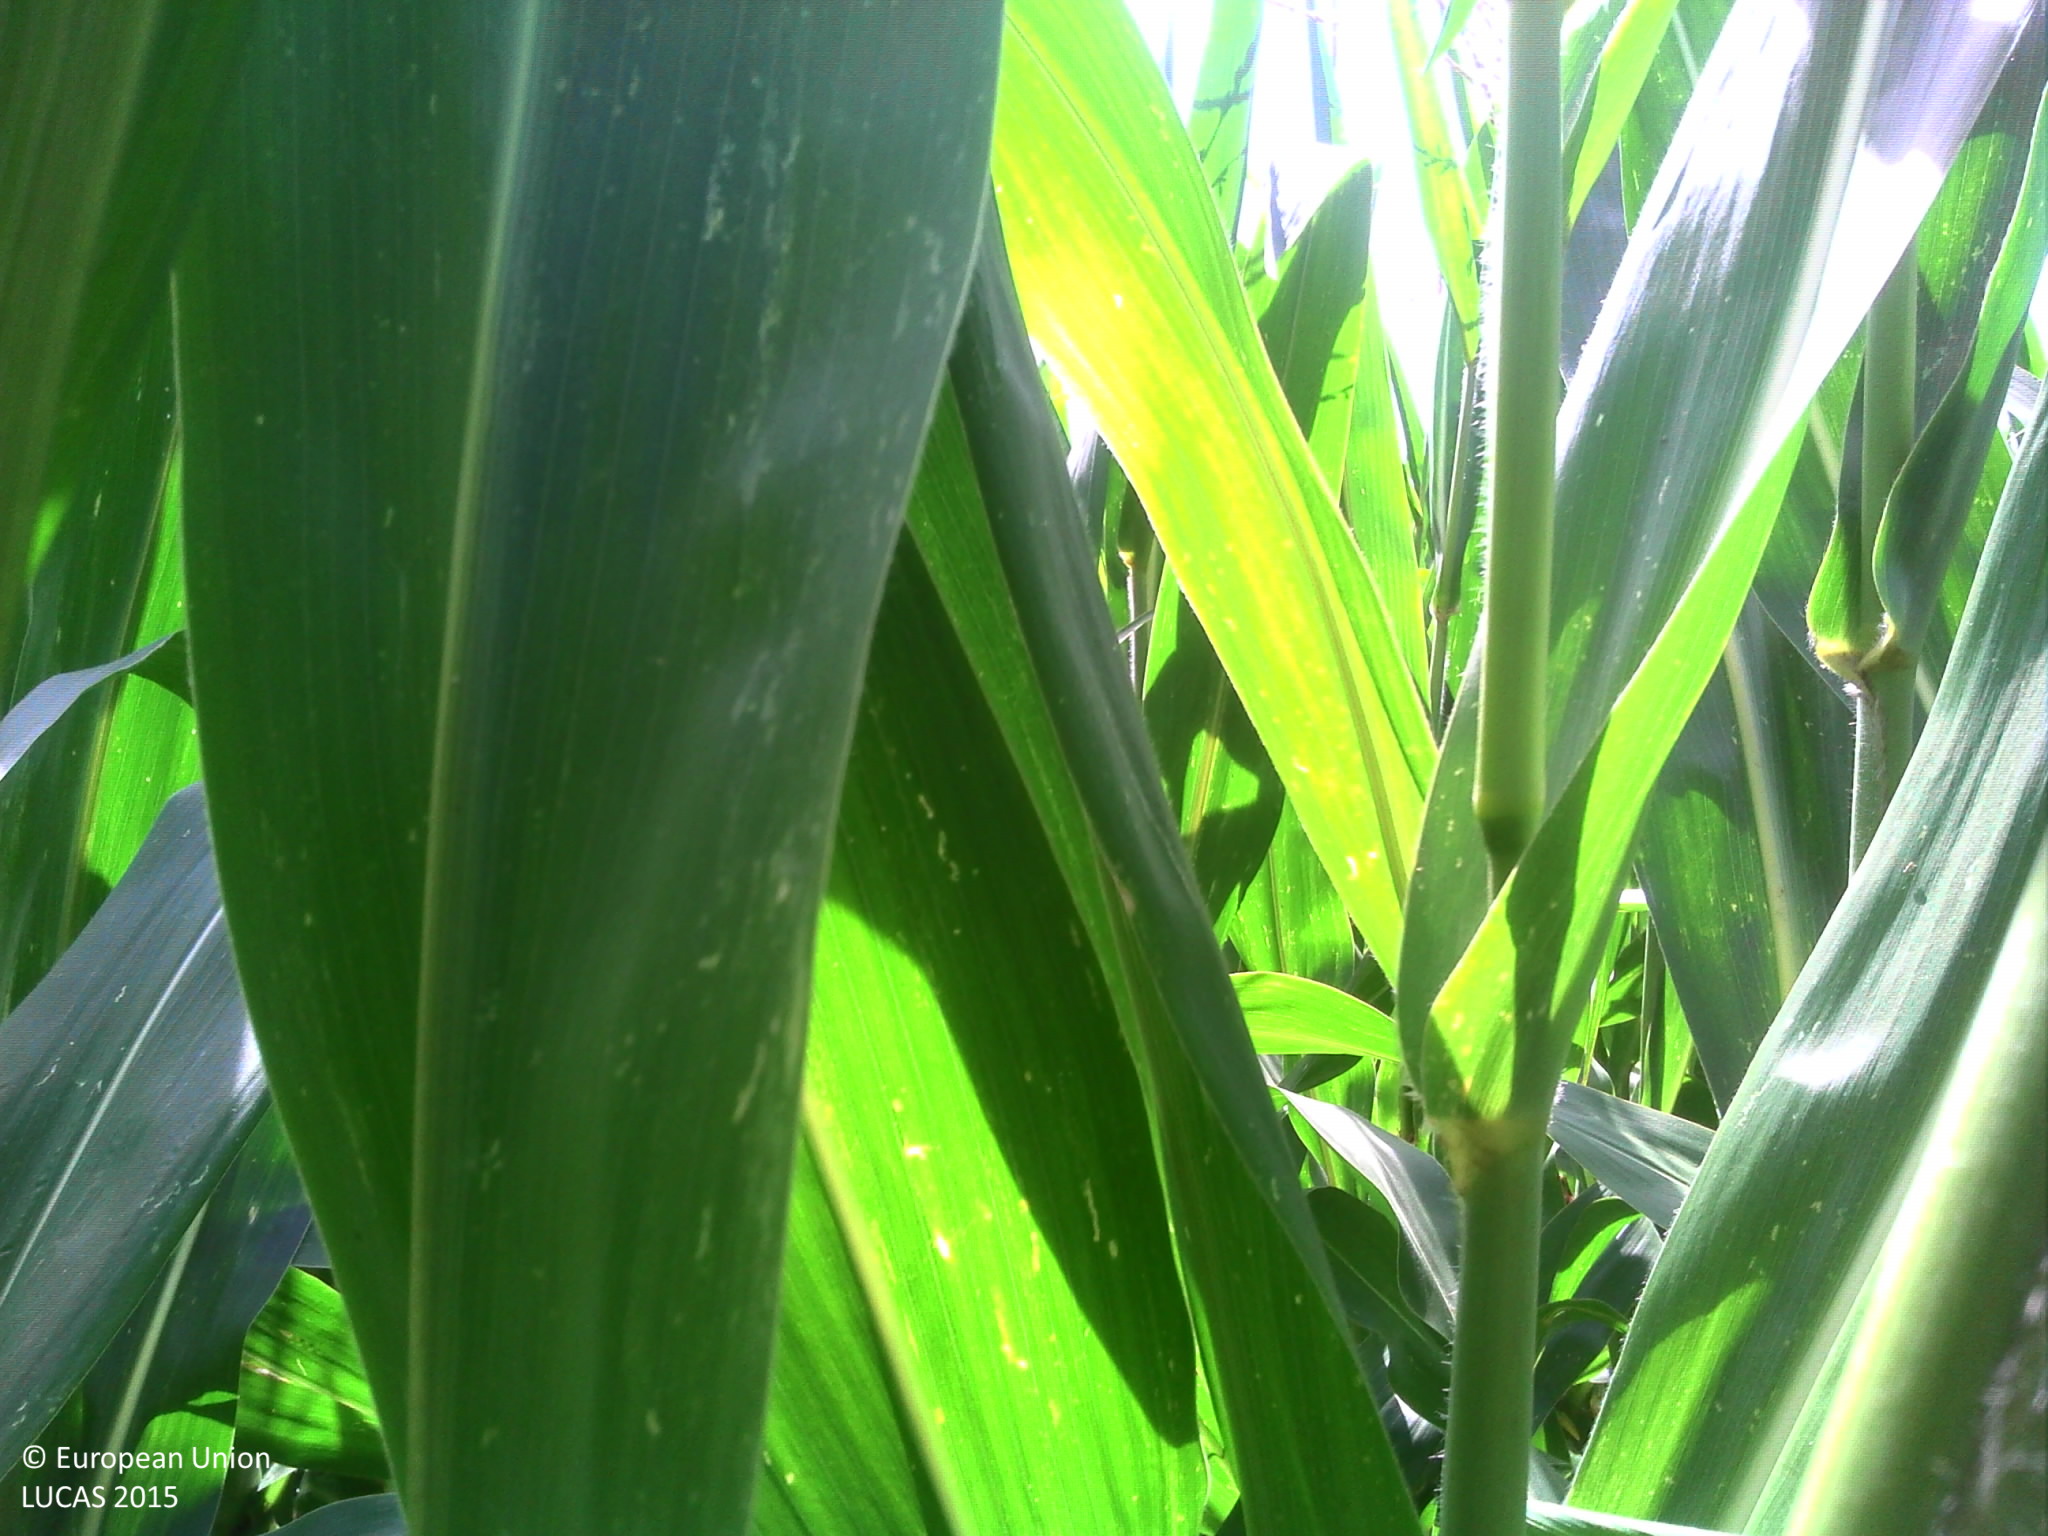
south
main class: Cropland
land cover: Maize
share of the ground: > 75 %
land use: Agriculture (excluding fallow land and kitchen gardens)
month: August
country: FR
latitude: 46.7665
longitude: -1.6558
